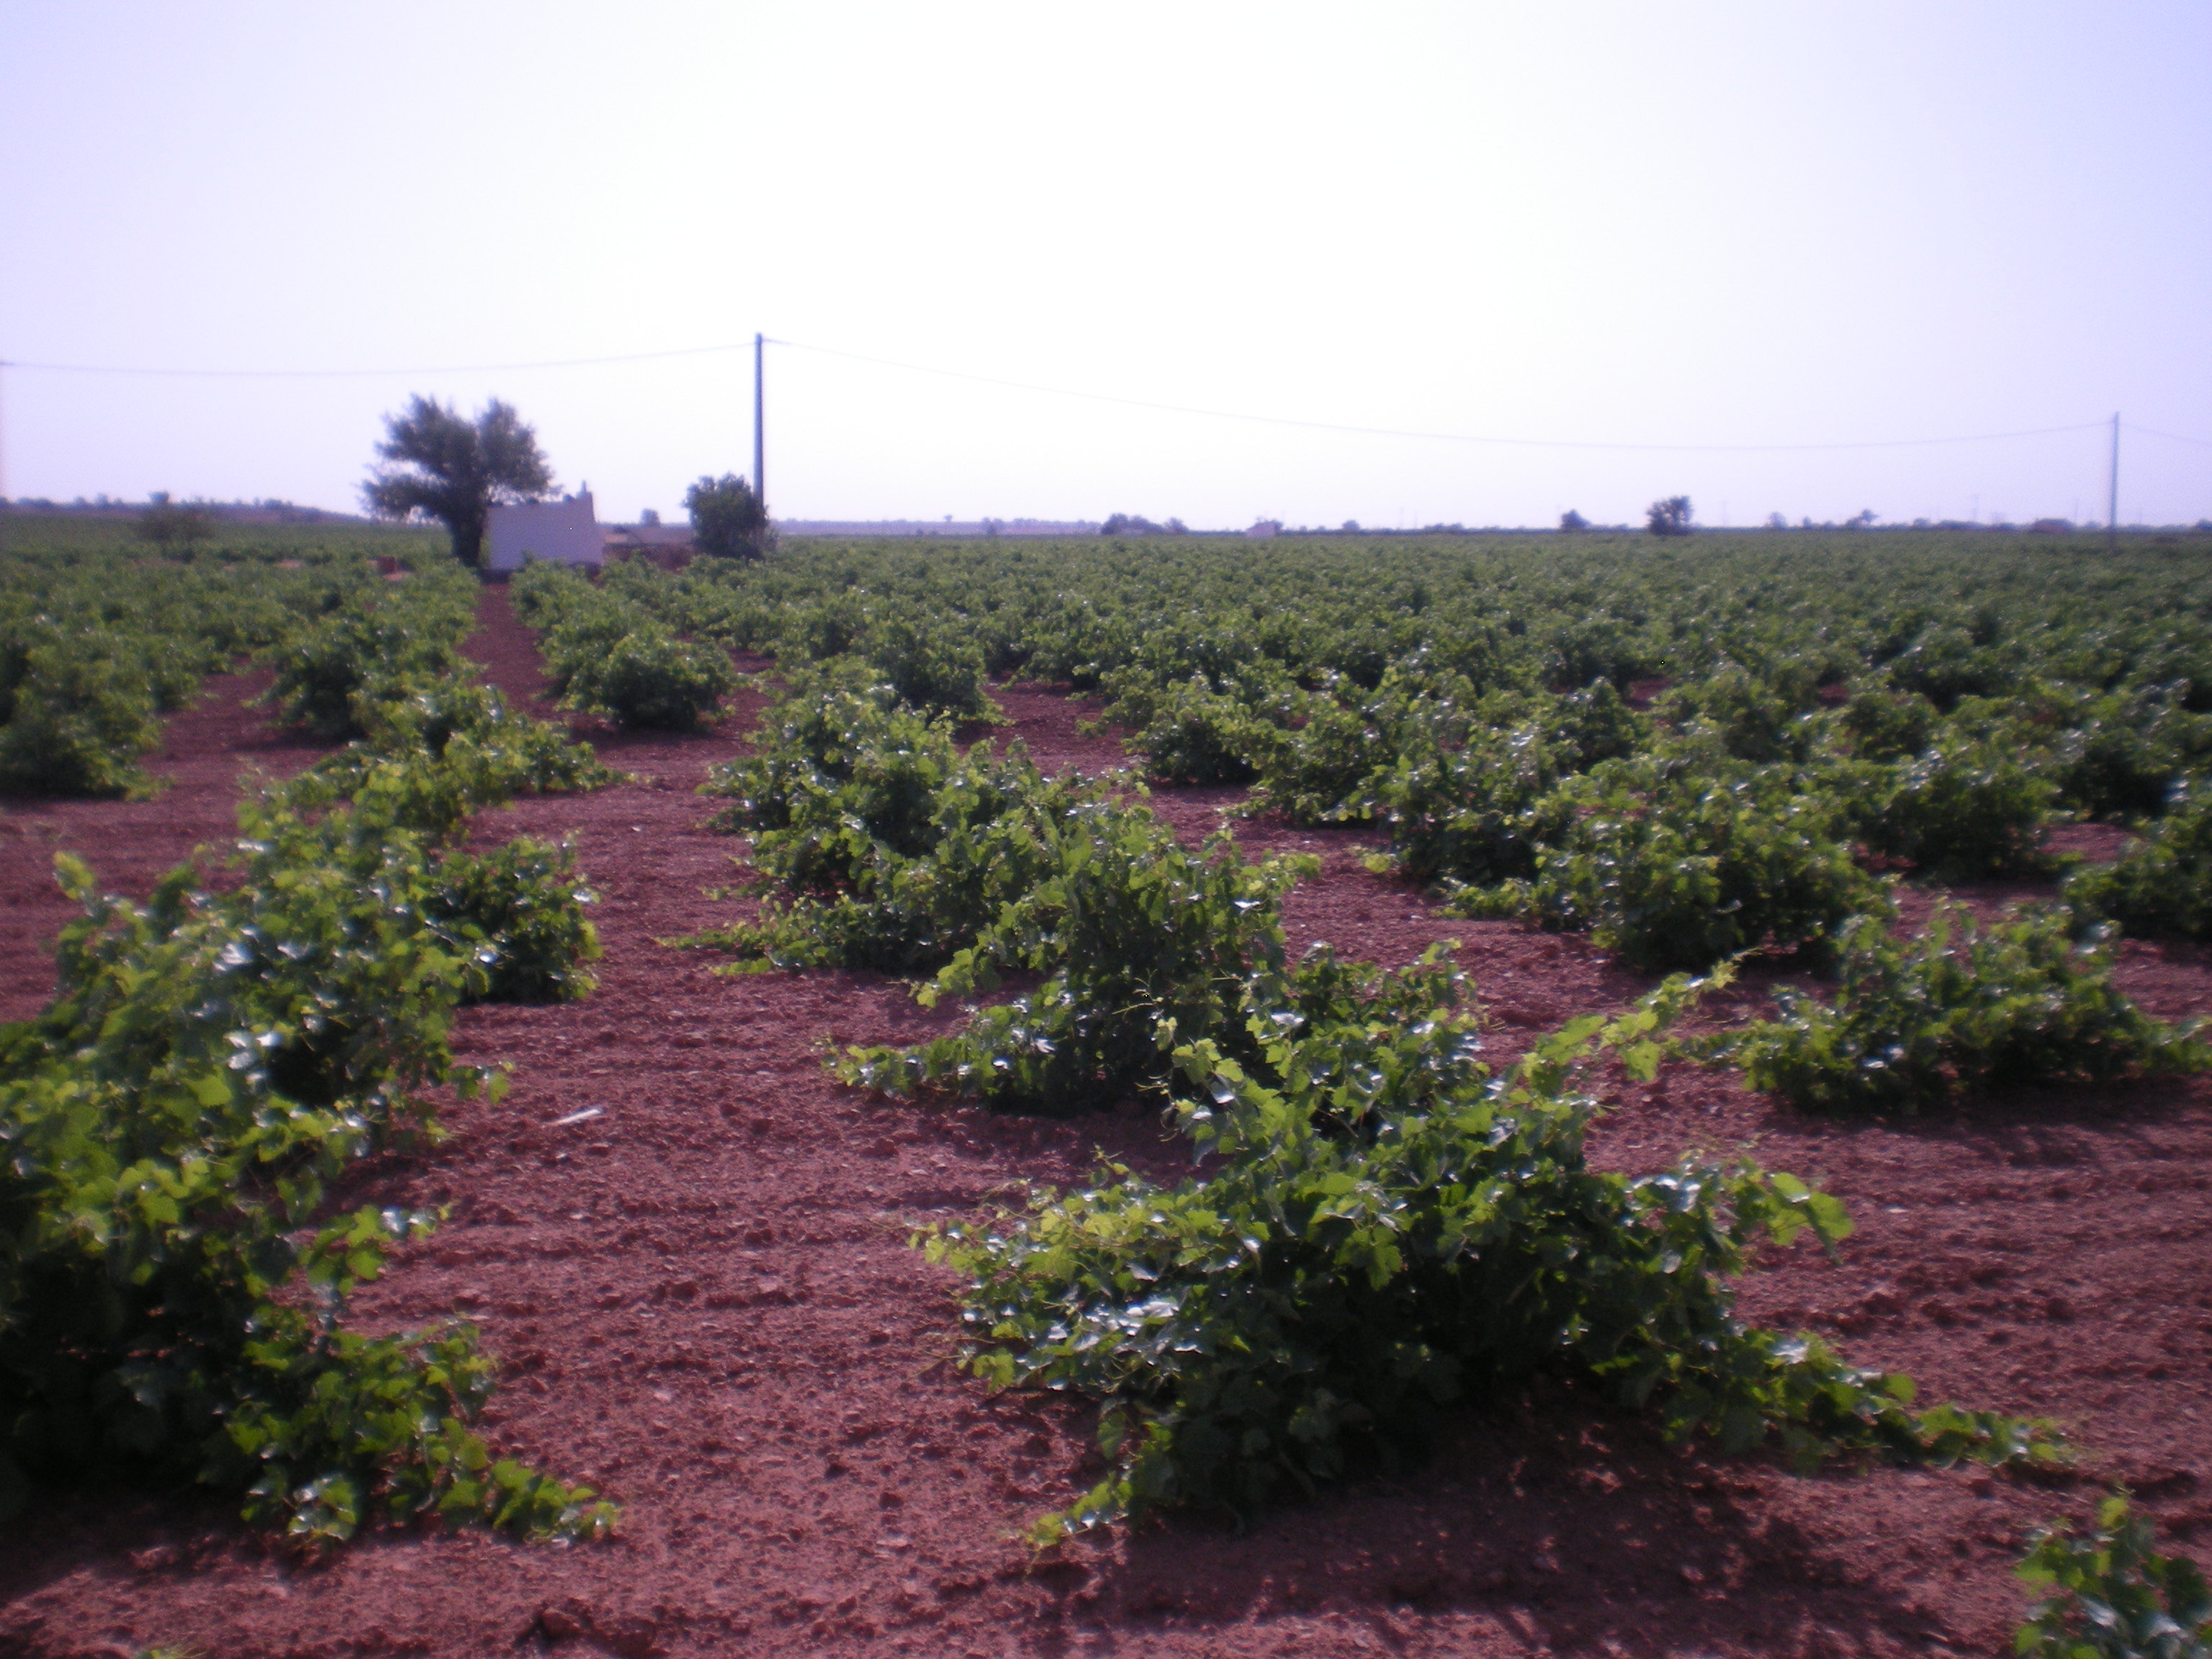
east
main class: Cropland
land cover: Vineyards
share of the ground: 10 - 25 %
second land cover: Other bare soil
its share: > 75 %
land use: Agriculture (excluding fallow land and kitchen gardens)
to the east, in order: Vineyards; Other bare soil; Electric lines; Vineyards
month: July
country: ES
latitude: 39.5063
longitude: -3.1490
